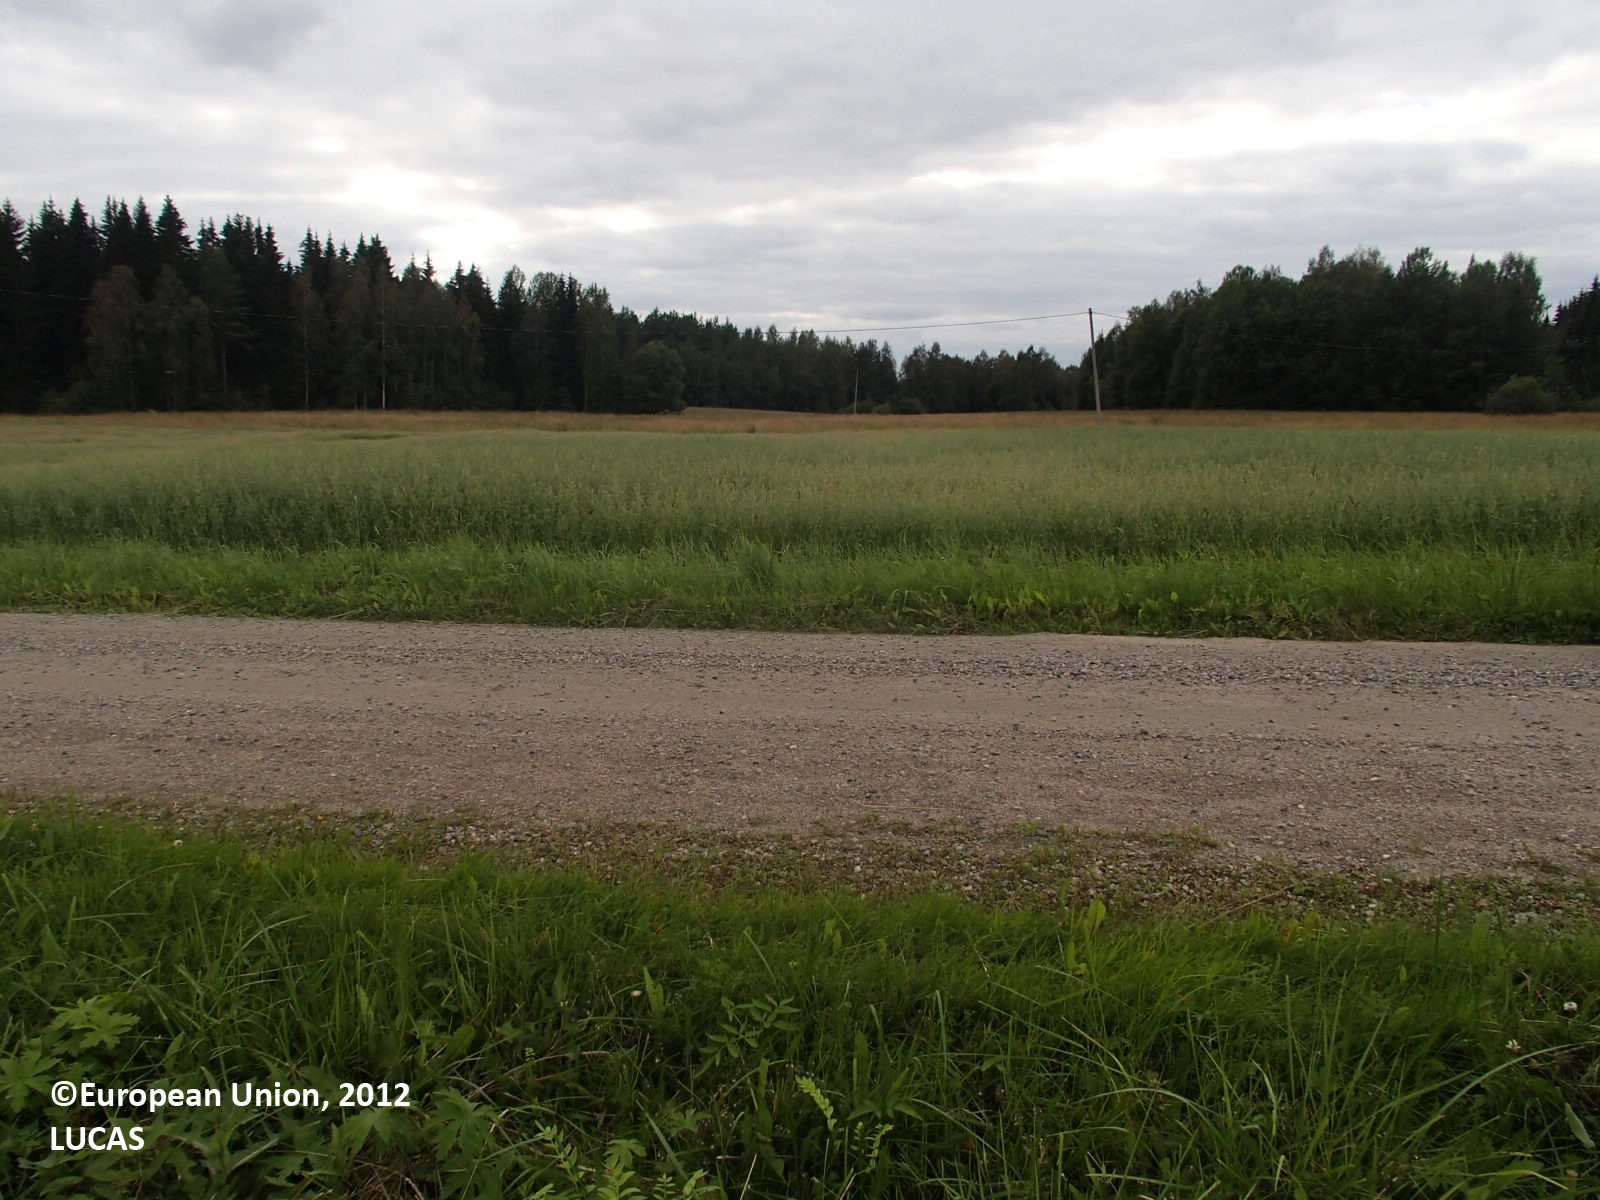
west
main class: Cropland
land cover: Oats
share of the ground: > 75 %
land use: Agriculture (excluding fallow land and kitchen gardens)
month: August
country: FI
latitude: 63.6335
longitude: 27.1988
